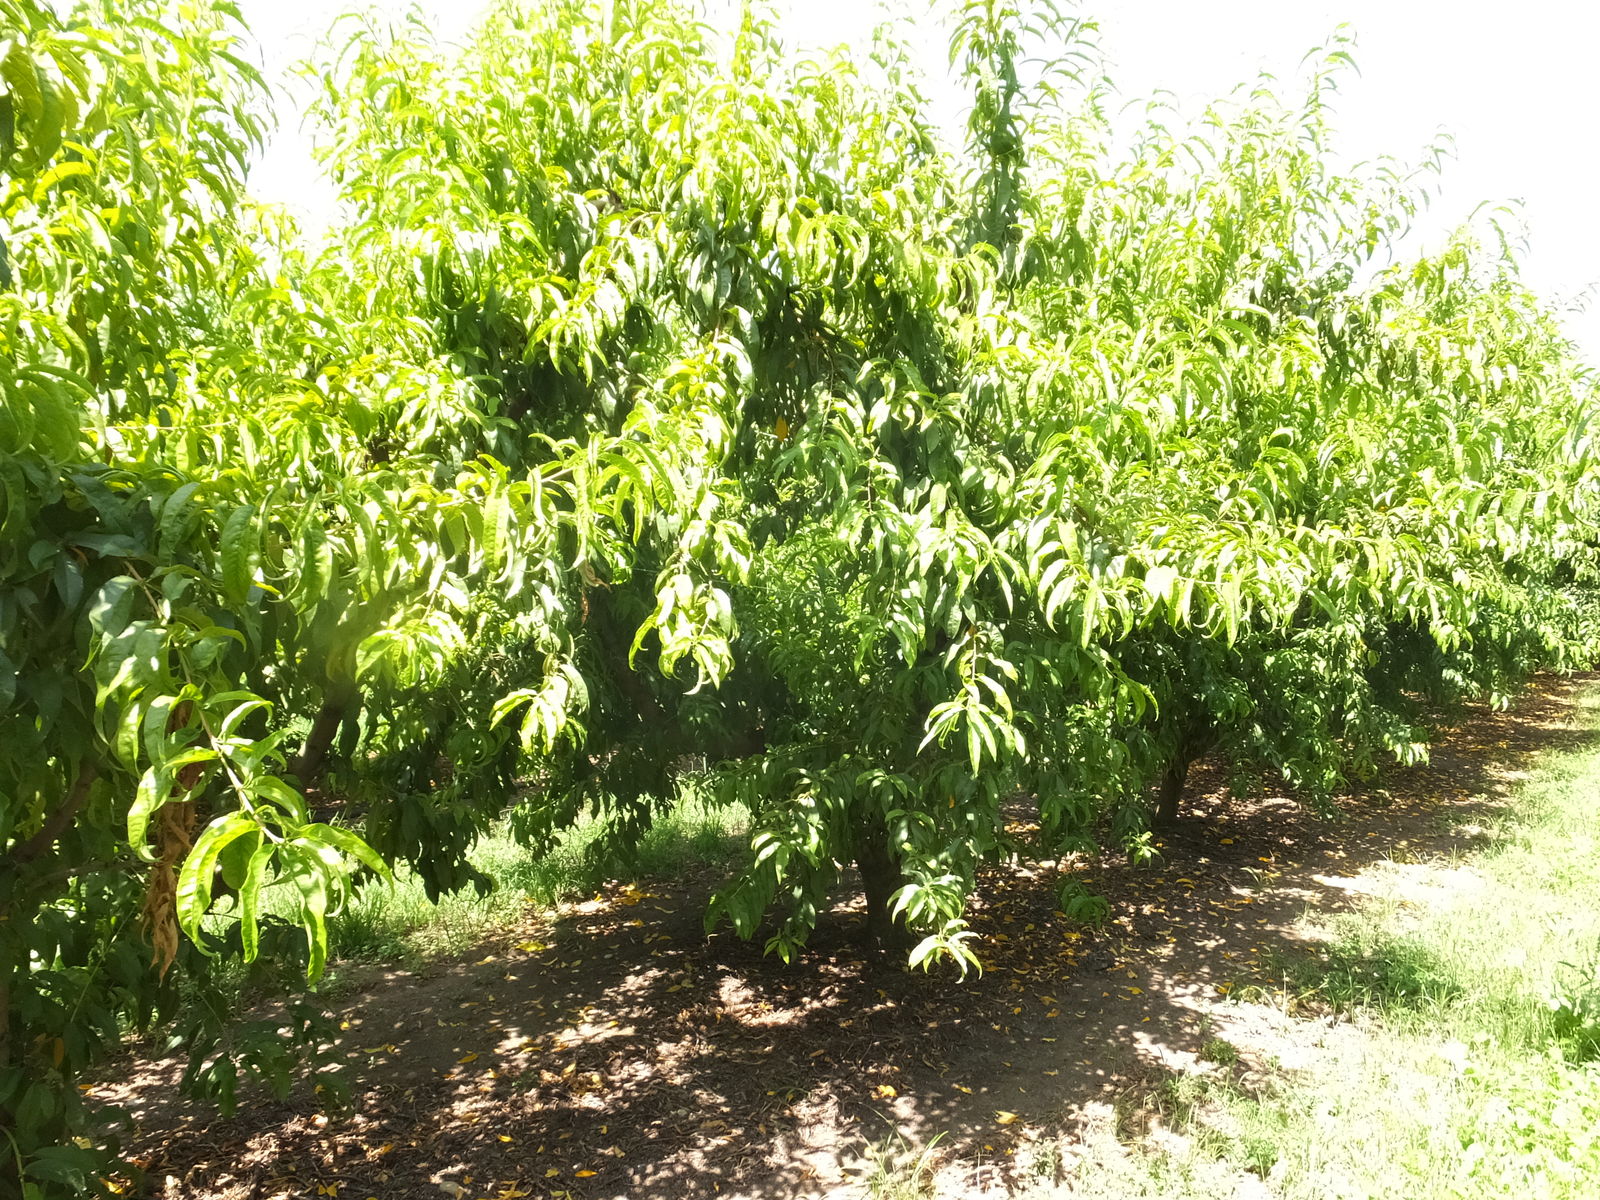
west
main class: Cropland
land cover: Other fruit trees and berries
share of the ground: > 75 %
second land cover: Spontaneously vegetated surfaces
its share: 10 - 25 %
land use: Agriculture (excluding fallow land and kitchen gardens)
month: July
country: ES
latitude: 41.5145
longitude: 0.4860
